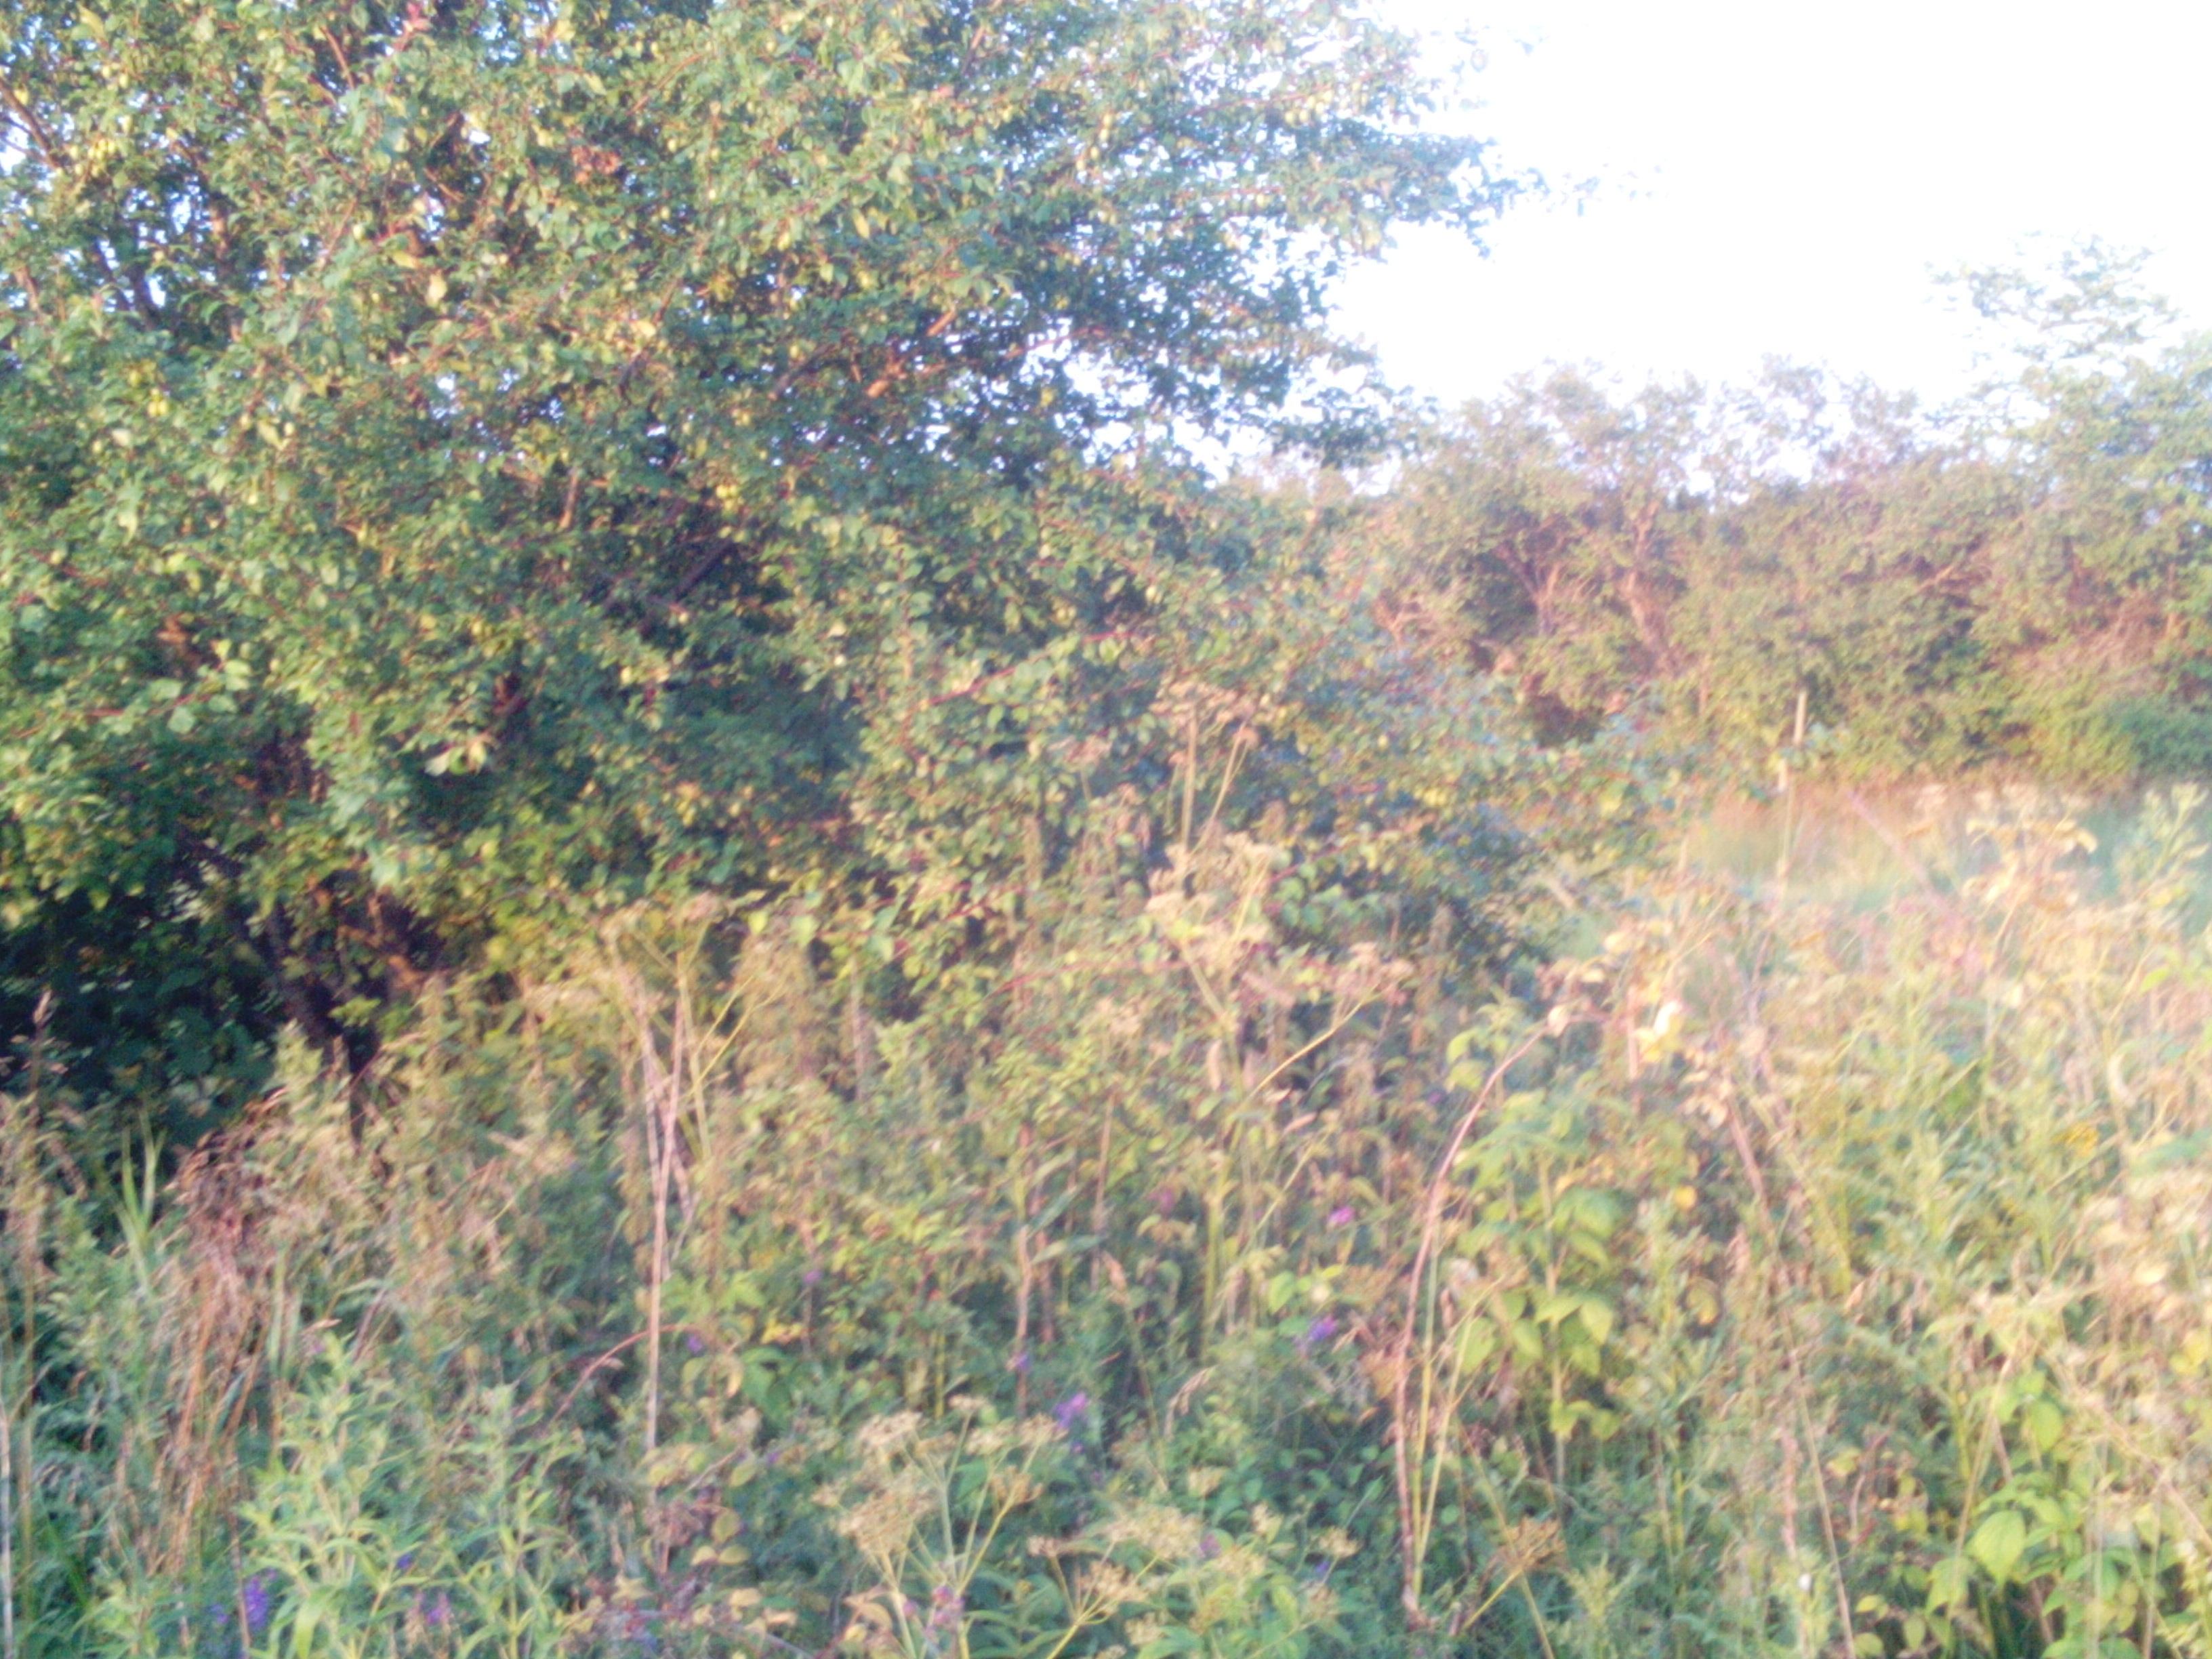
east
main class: Grassland
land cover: Spontaneously vegetated surfaces
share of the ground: > 75 %
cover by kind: herbaceous plants 90 %
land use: Semi-natural and natural areas not in use
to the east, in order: Spontaneously vegetated surfaces; Shrubland without tree cover; Inland fresh running water; Grassland without tree/shrub cover; Broadleaved woodland; Grassland without tree/shrub cover; Ditches and canals; Grassland without tree/shrub cover; Broadleaved woodland
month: July
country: LV
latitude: 56.3526
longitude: 21.7791
